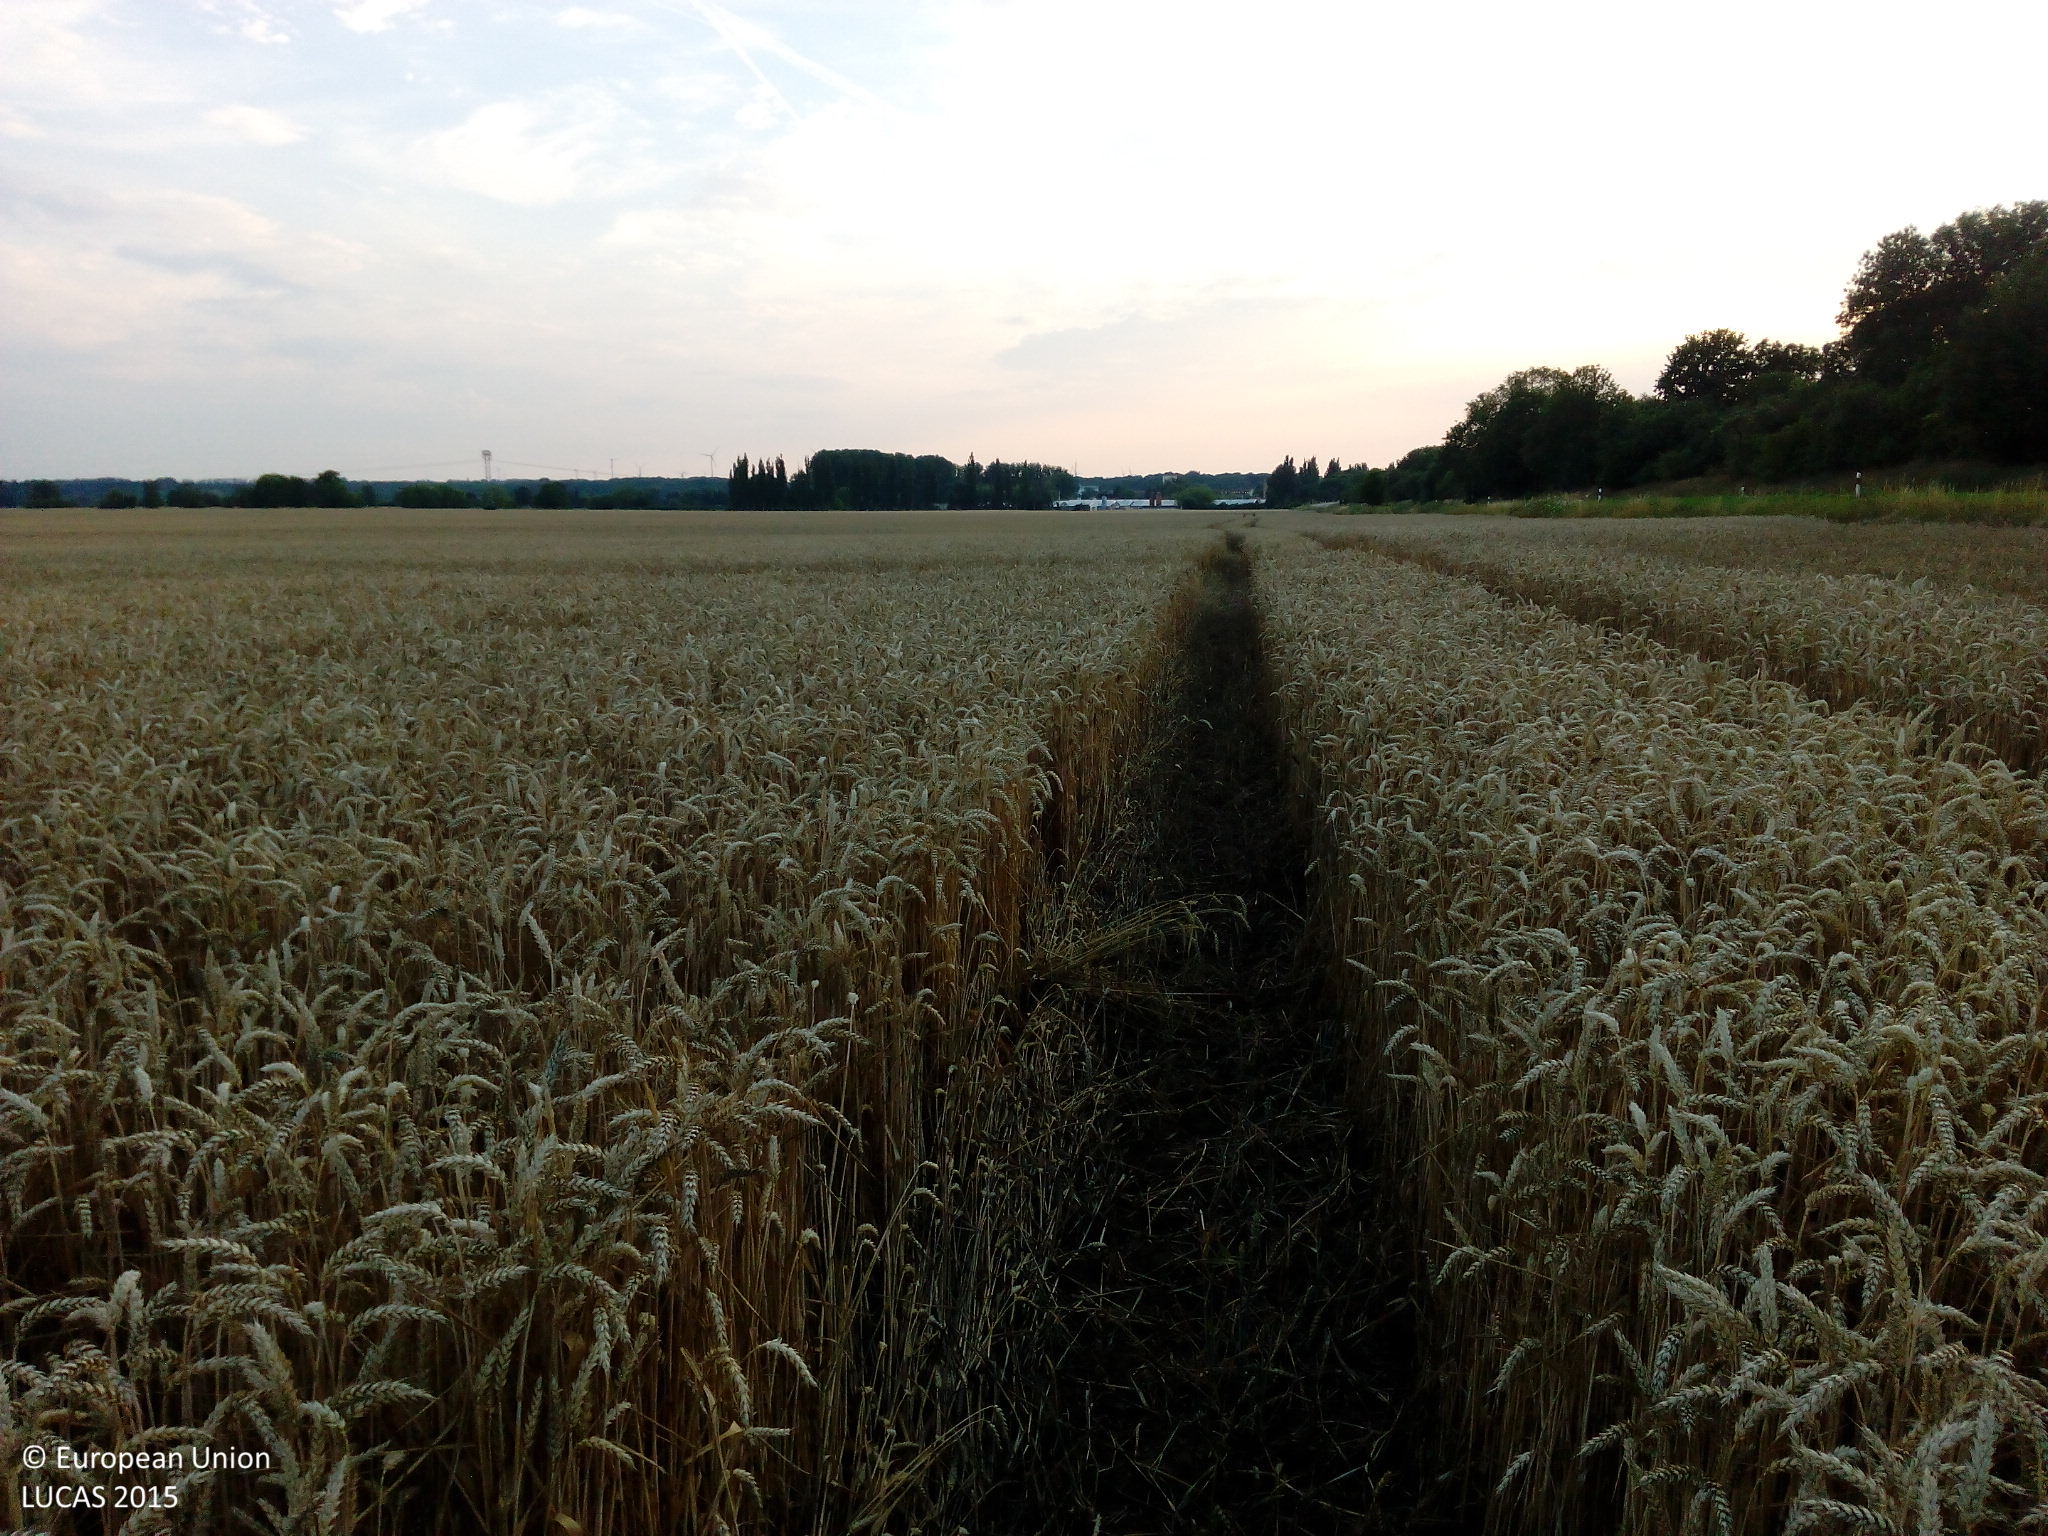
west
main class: Cropland
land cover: Common wheat
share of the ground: > 75 %
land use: Agriculture (excluding fallow land and kitchen gardens)
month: July
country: DE
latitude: 52.7186
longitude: 14.1610
